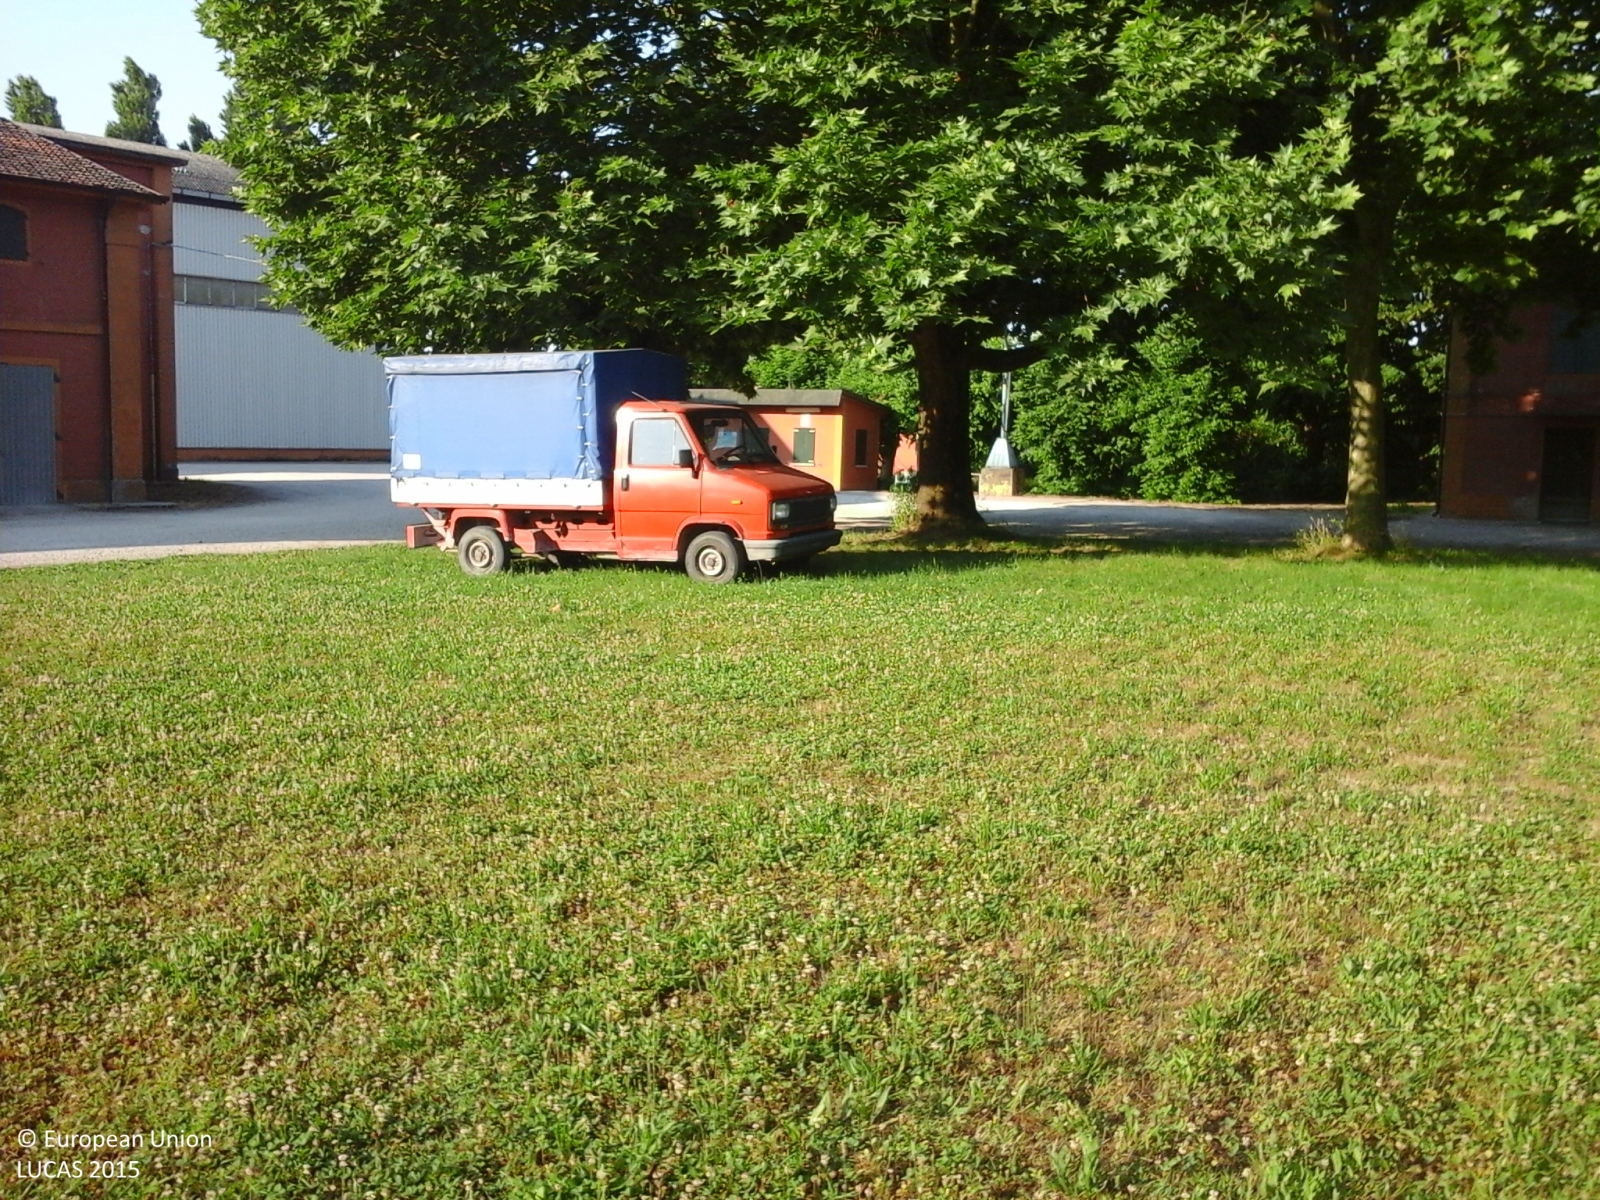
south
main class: Grassland
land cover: Grassland without tree/shrub cover
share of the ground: > 75 %
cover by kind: herbaceous plants 100 %
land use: Agriculture (excluding fallow land and kitchen gardens)
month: June
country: IT
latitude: 44.6073
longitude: 11.6975
